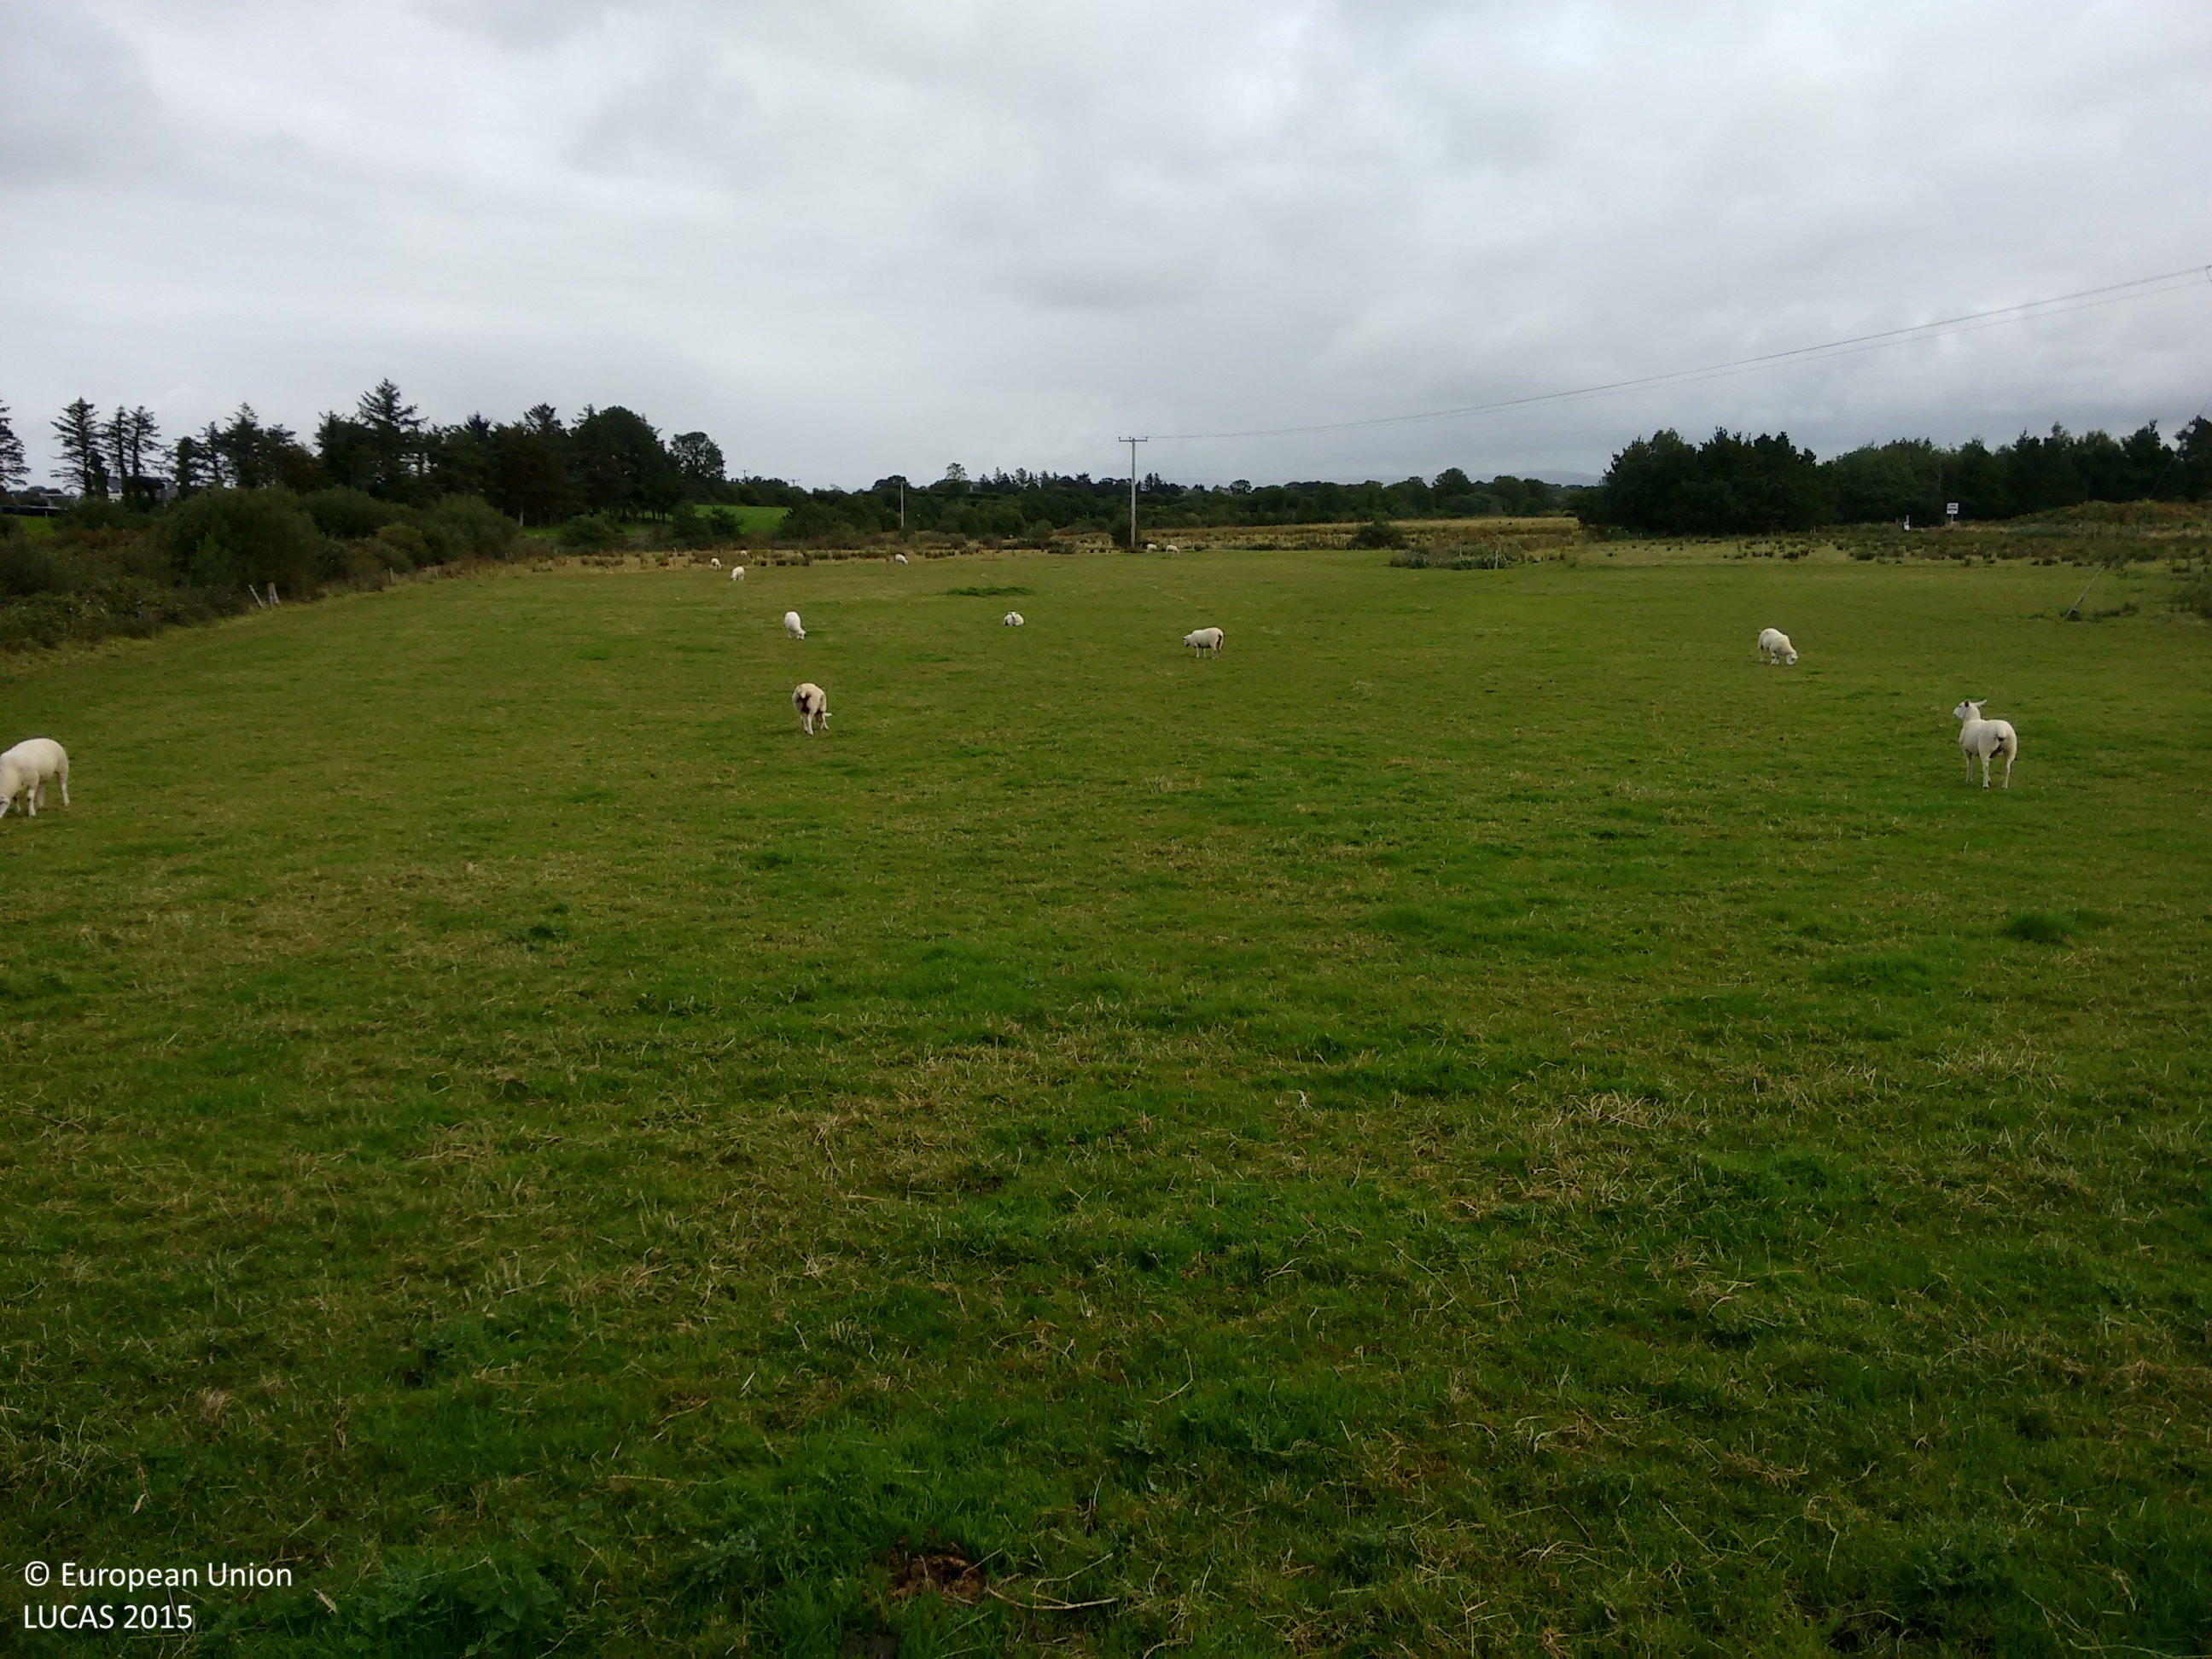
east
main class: Grassland
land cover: Grassland without tree/shrub cover
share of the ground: > 75 %
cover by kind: herbaceous plants 100 %
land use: Agriculture (excluding fallow land and kitchen gardens)
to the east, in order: Grassland without tree/shrub cover; Electric lines; Grassland without tree/shrub cover; Fences; Ditches and canals; Fences; Grassland without tree/shrub cover; Fences; Ditches and canals
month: September
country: IE
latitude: 54.0943
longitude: -9.2580
